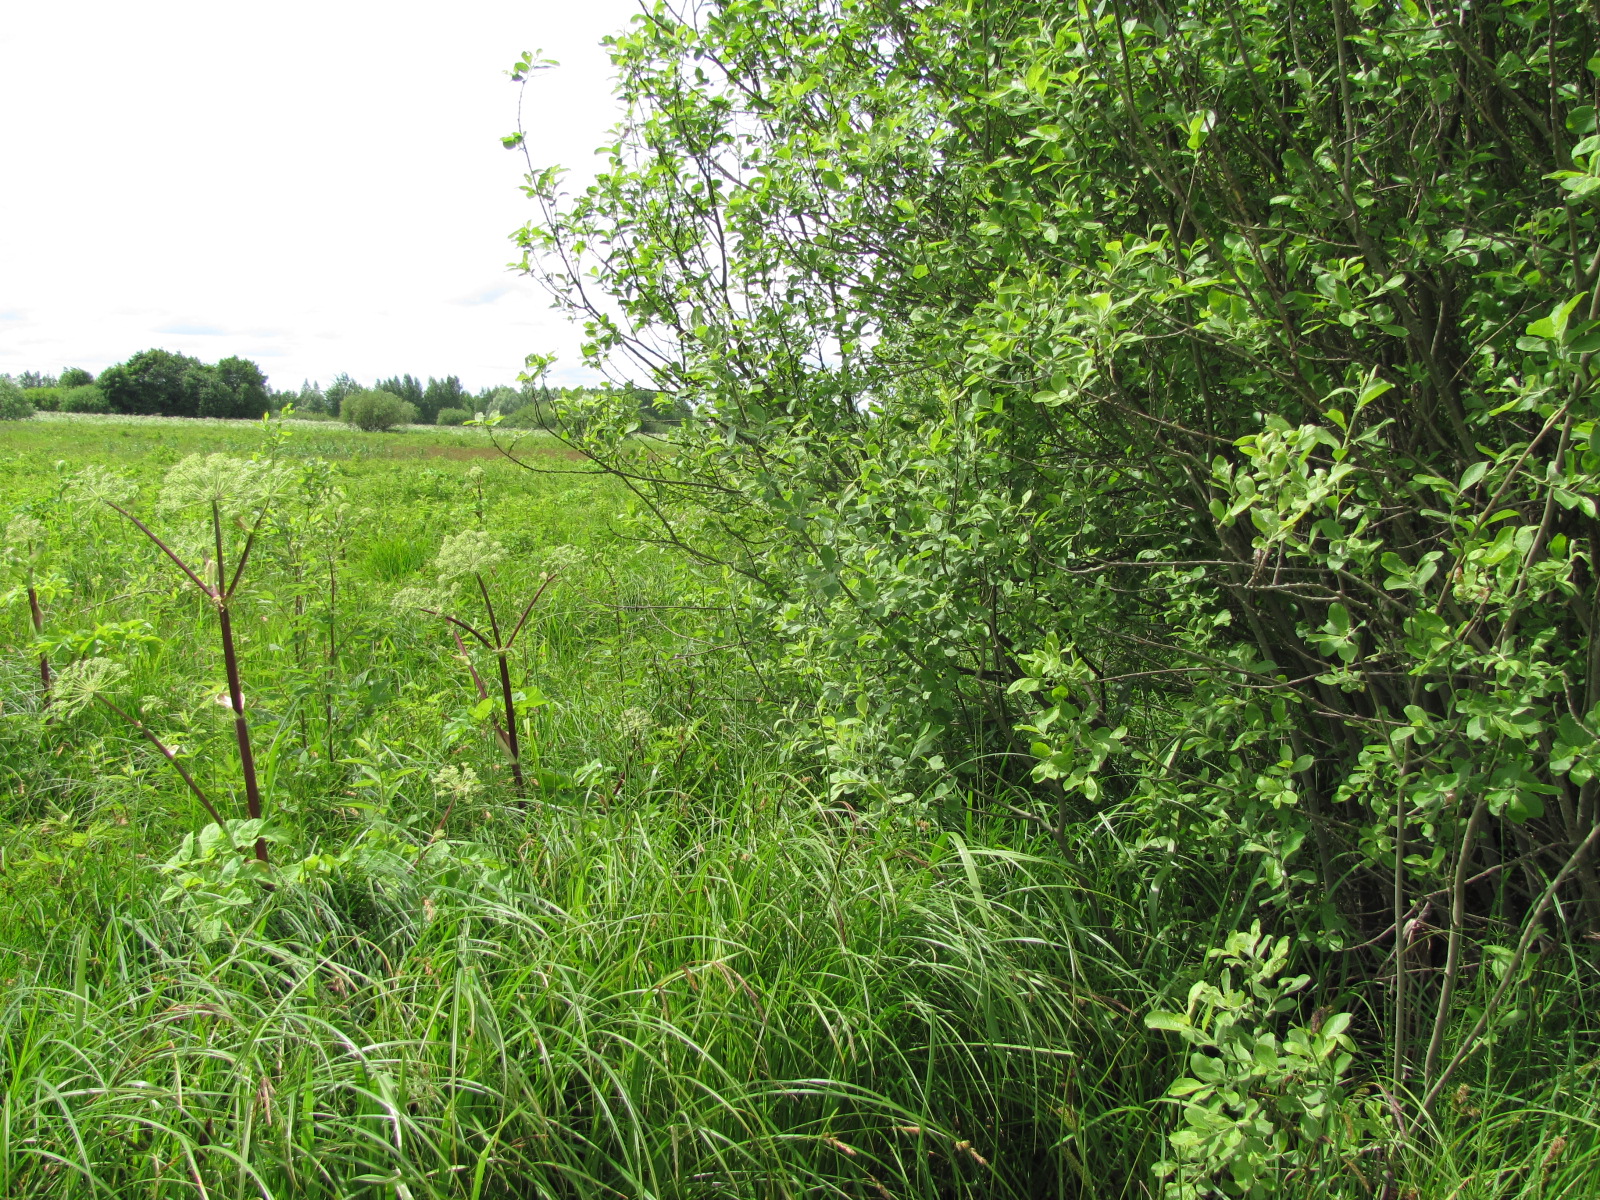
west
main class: Grassland
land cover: Grassland without tree/shrub cover
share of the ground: > 75 %
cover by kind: herbaceous plants 100 %
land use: Semi-natural and natural areas not in use
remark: Temporary flooded
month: June
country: LV
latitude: 56.6440
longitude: 23.7946
